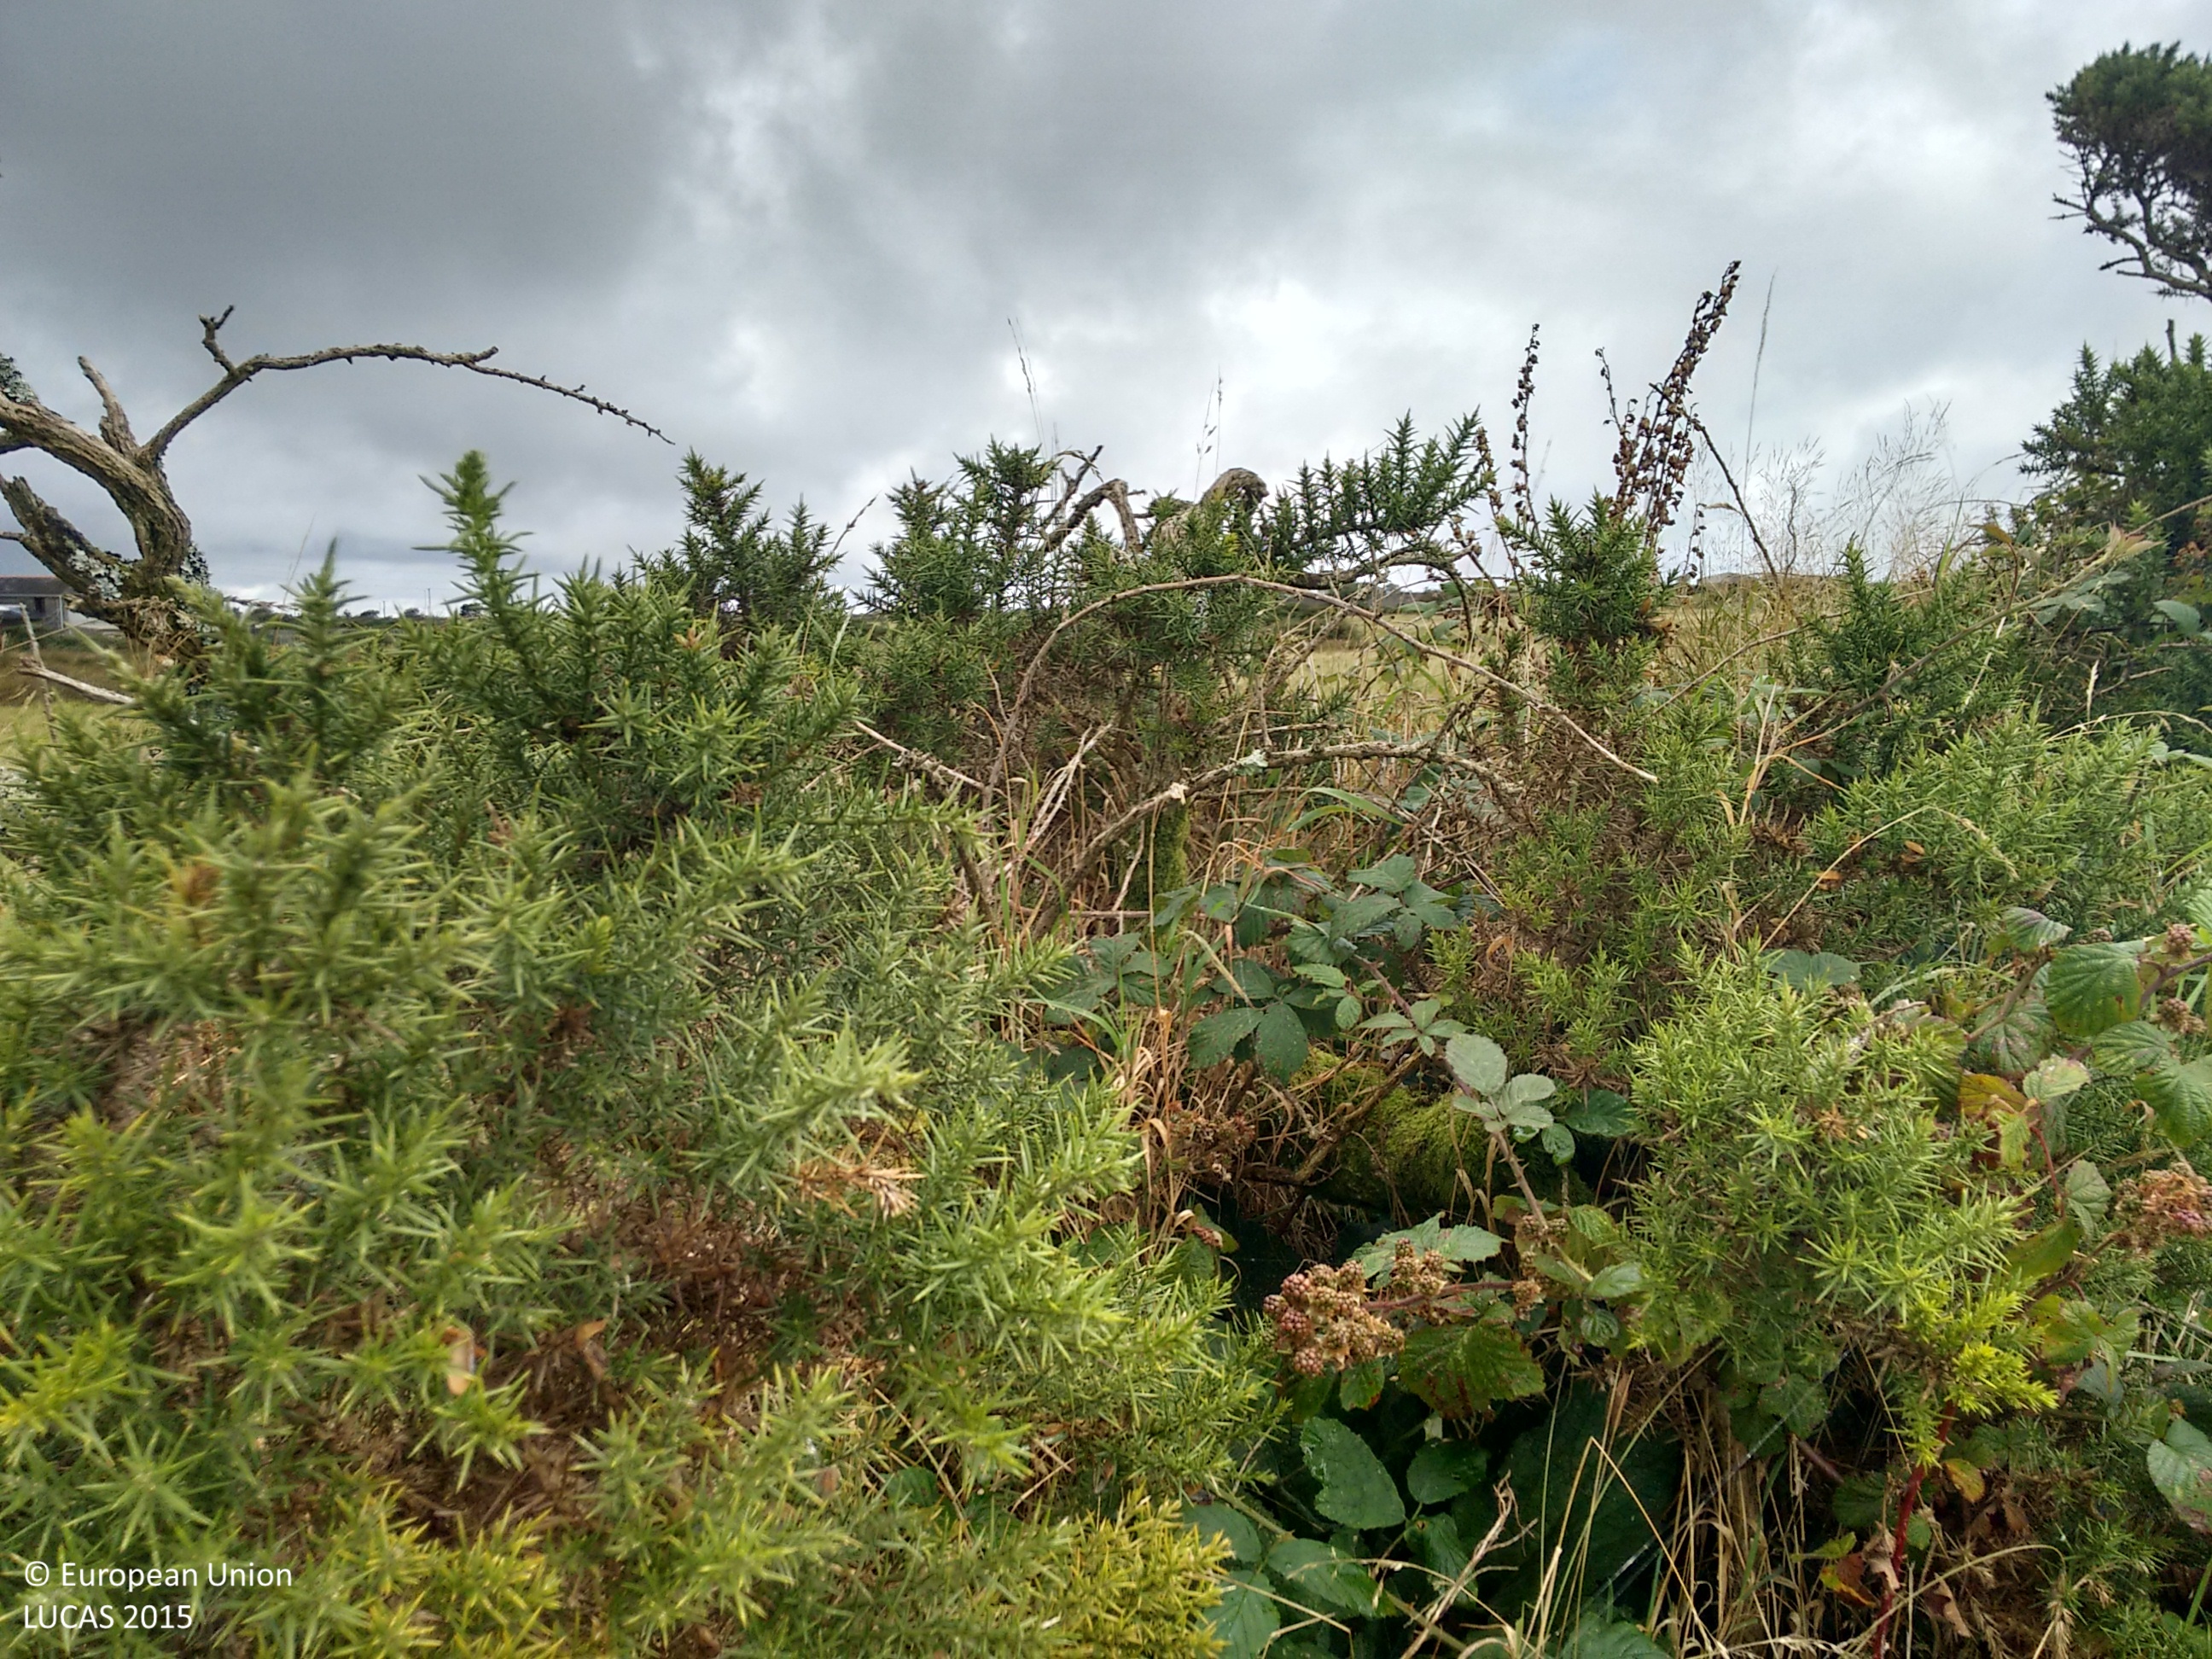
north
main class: Grassland
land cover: Grassland without tree/shrub cover
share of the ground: > 75 %
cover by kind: herbaceous plants 100 %
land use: Agriculture (excluding fallow land and kitchen gardens)
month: September
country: GB
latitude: 50.1957
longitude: -5.2360
